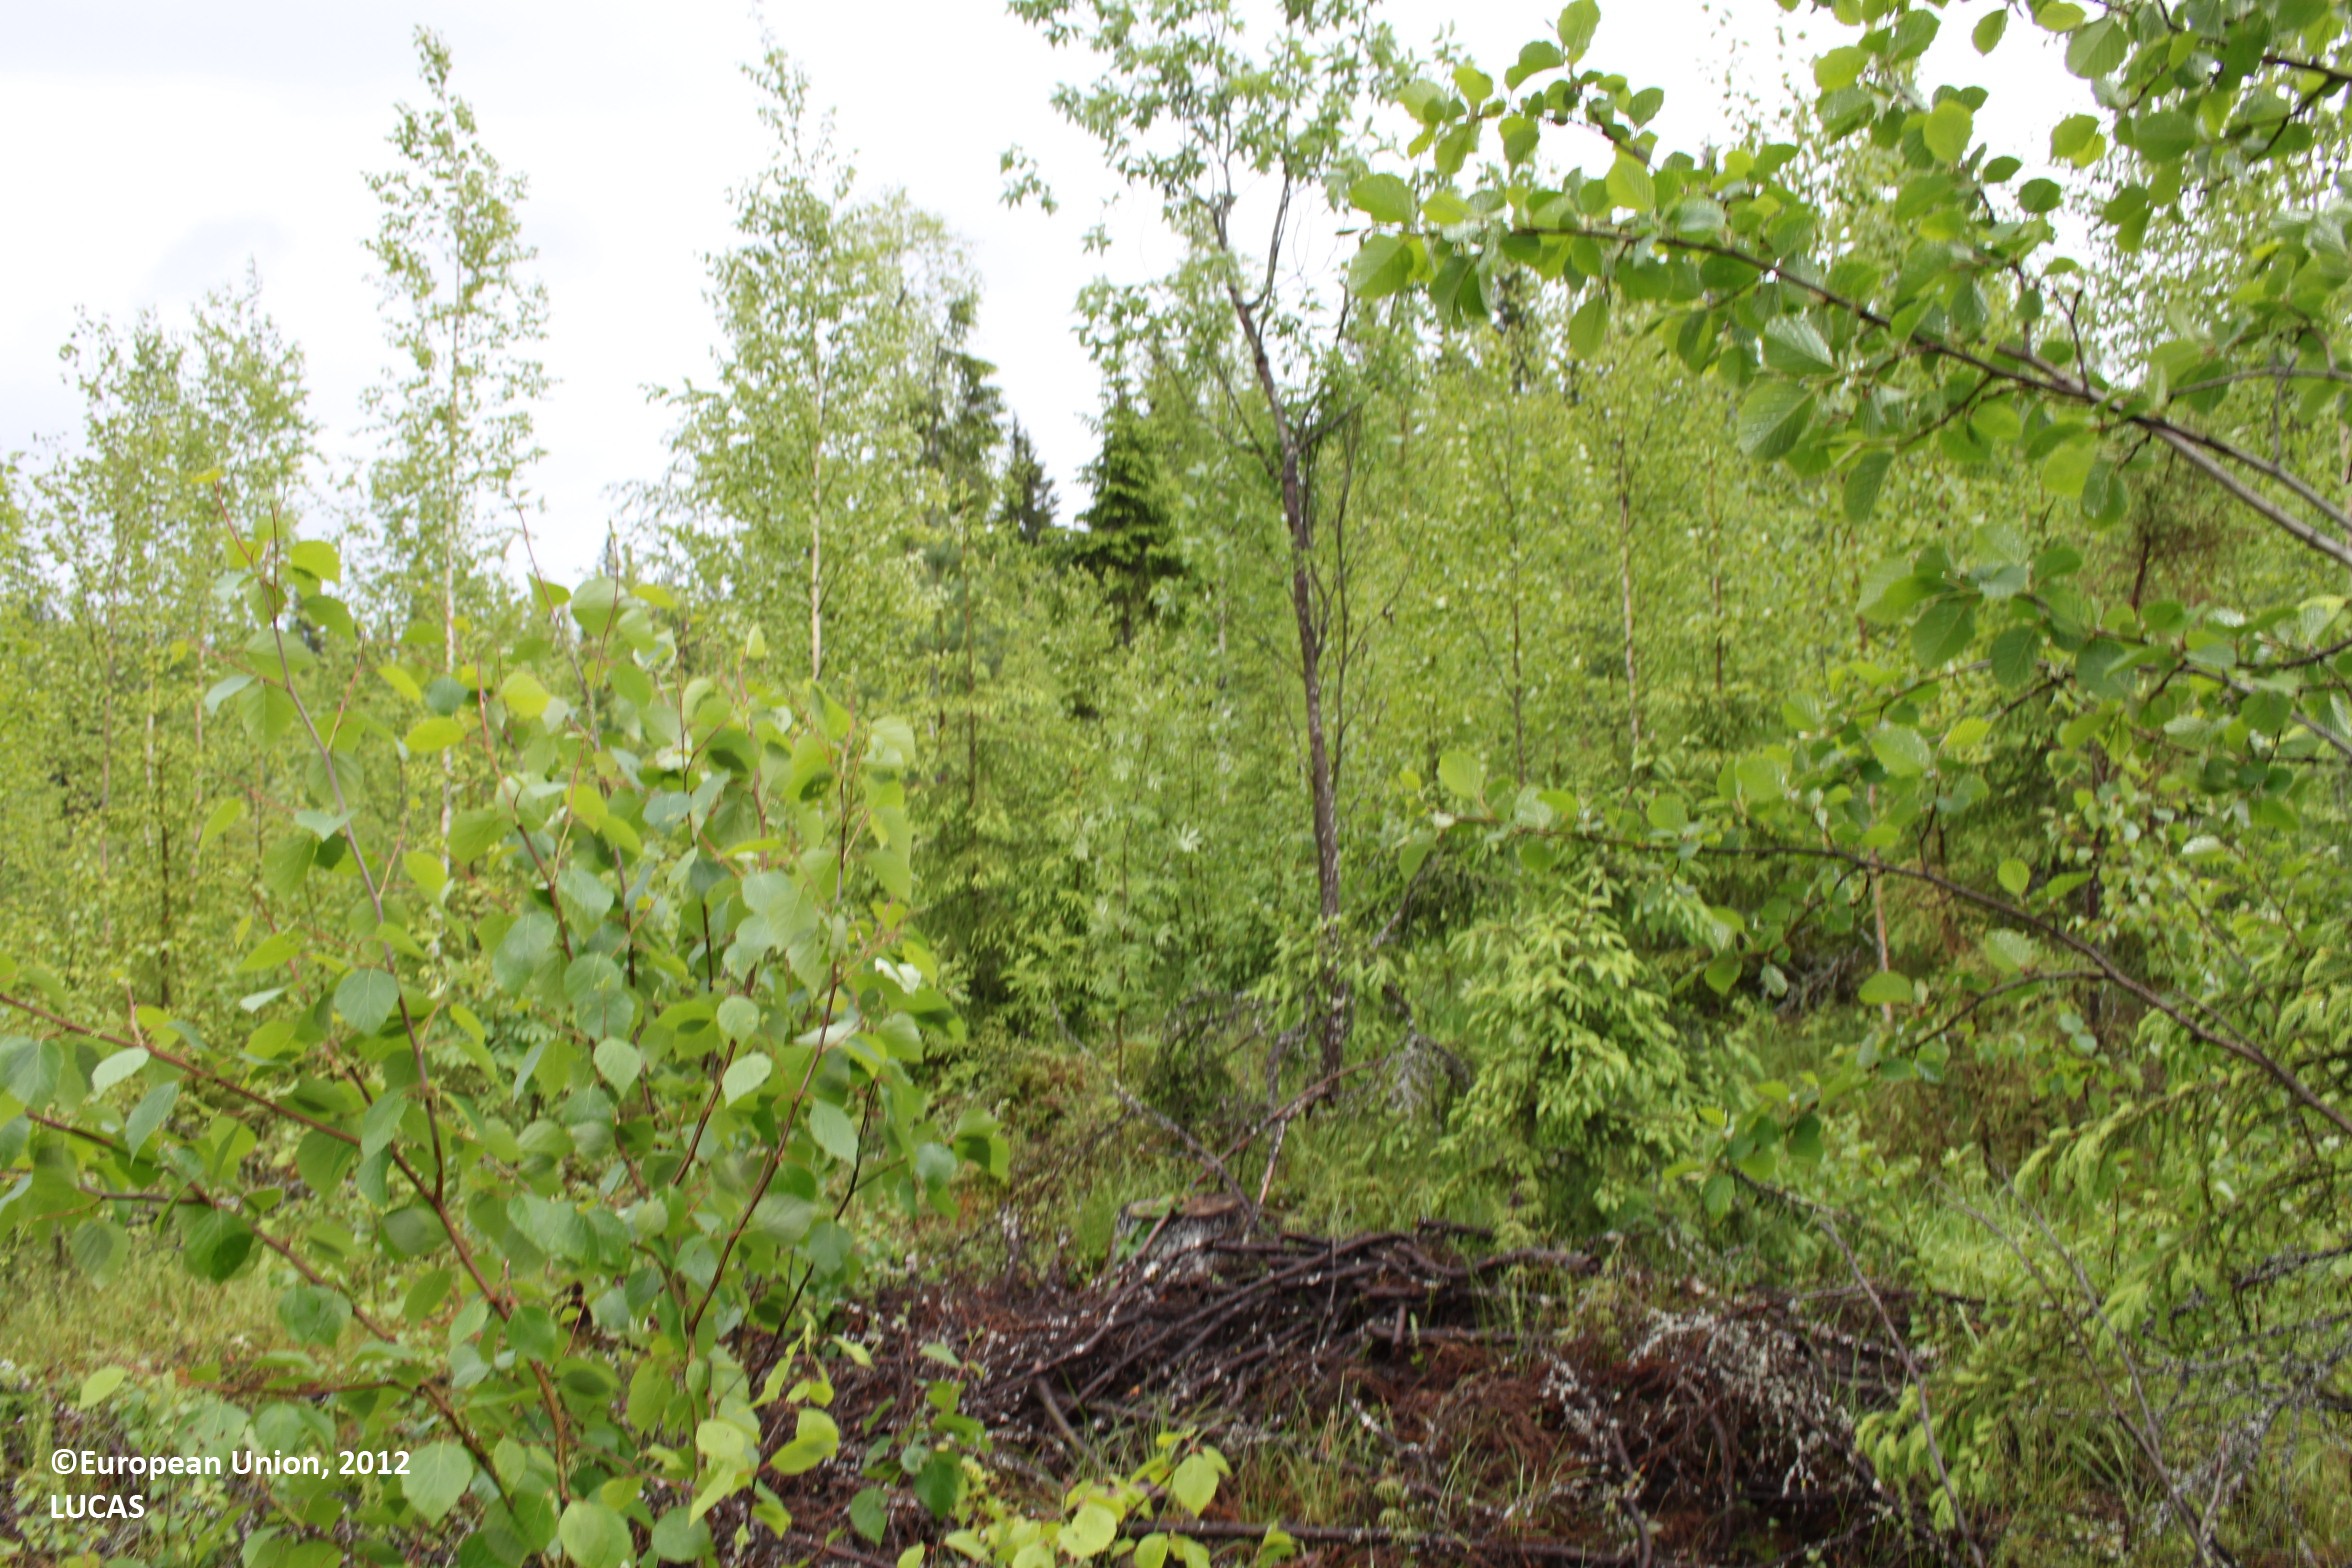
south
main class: Woodland
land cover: Broadleaved woodland
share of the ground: > 75 %
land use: Forestry
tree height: < 5 m
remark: Harvested field
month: June
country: FI
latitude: 61.8019
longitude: 28.3588
